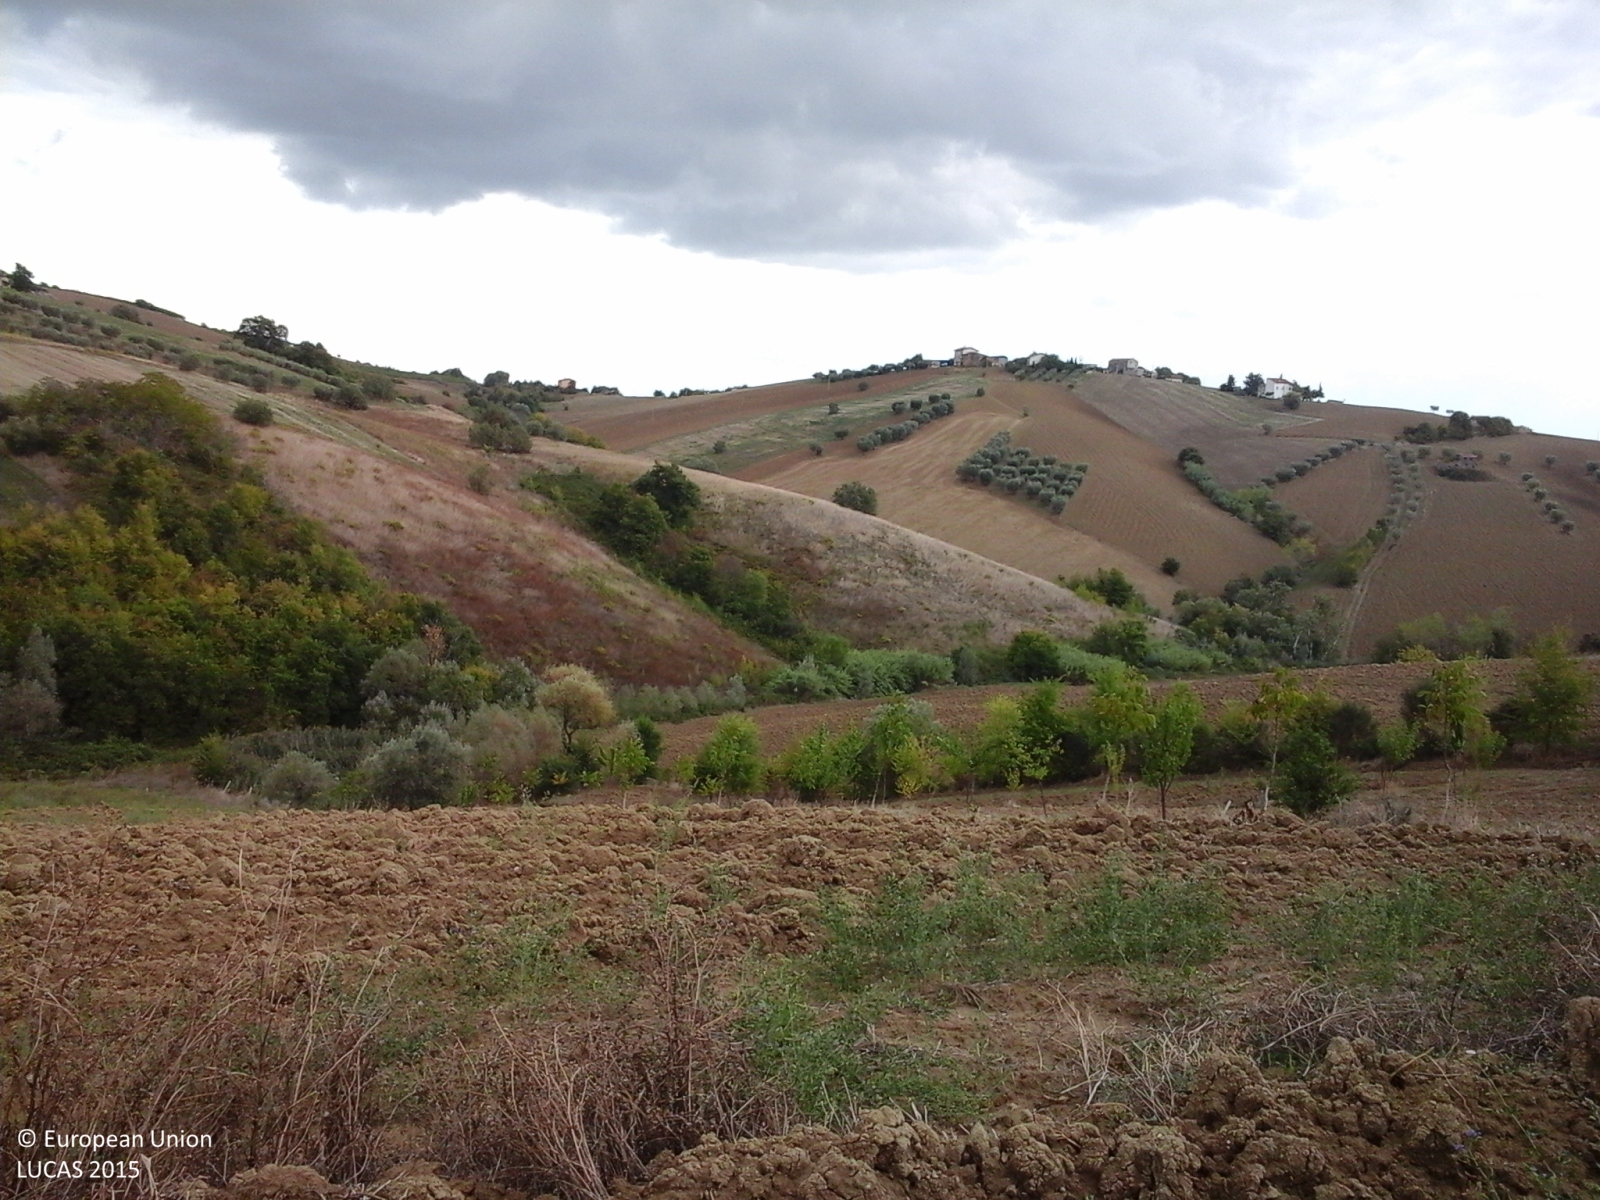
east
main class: Cropland
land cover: Lucerne
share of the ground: > 75 %
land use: Agriculture (excluding fallow land and kitchen gardens)
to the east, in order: Lucerne; Other bare soil; Lucerne; Single bushes/trees; Spontaneously vegetated surfaces; Other bare soil; Shrubland with sparse tree cover; Inland fresh water bodies; Shrubland with sparse tree cover; Broadleaved woodland; Other bare soil
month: September
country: IT
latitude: 42.8369
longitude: 13.7699
